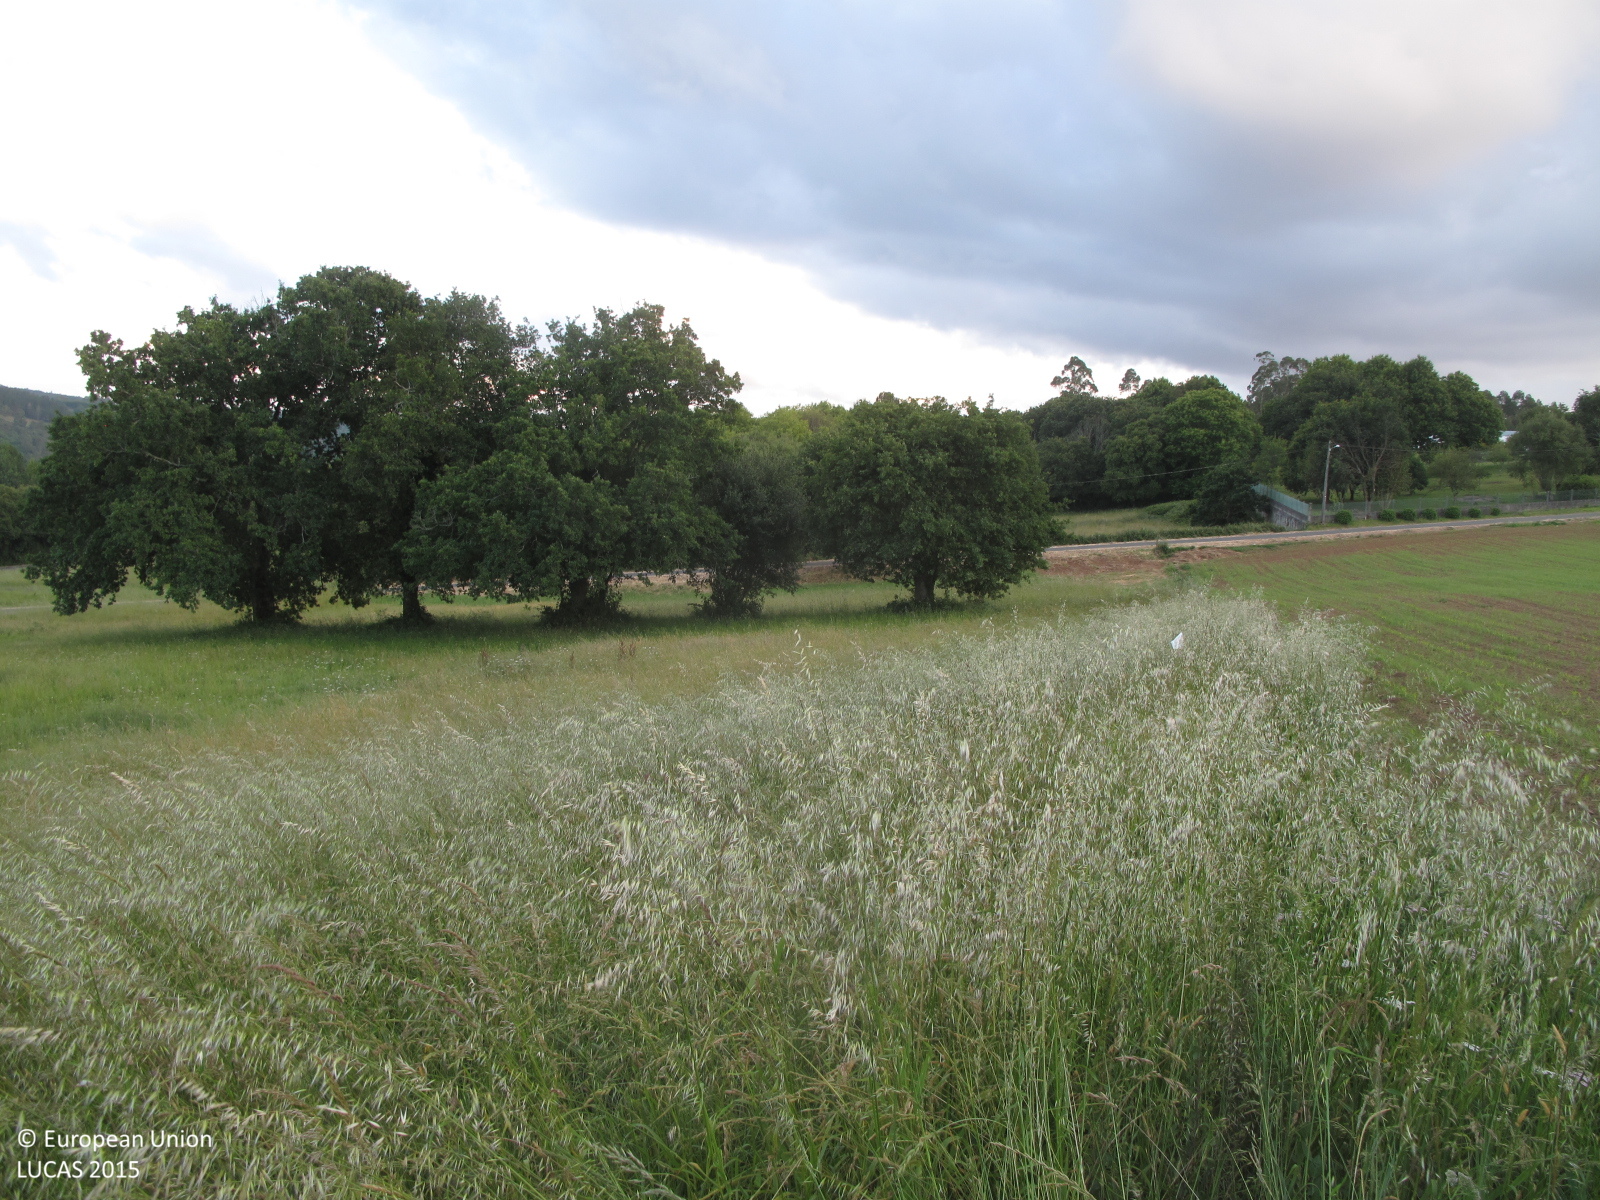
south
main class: Grassland
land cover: Grassland without tree/shrub cover
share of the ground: > 75 %
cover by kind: herbaceous plants 100 %
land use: Agriculture (excluding fallow land and kitchen gardens)
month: June
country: ES
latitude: 42.8719
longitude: -8.5021
